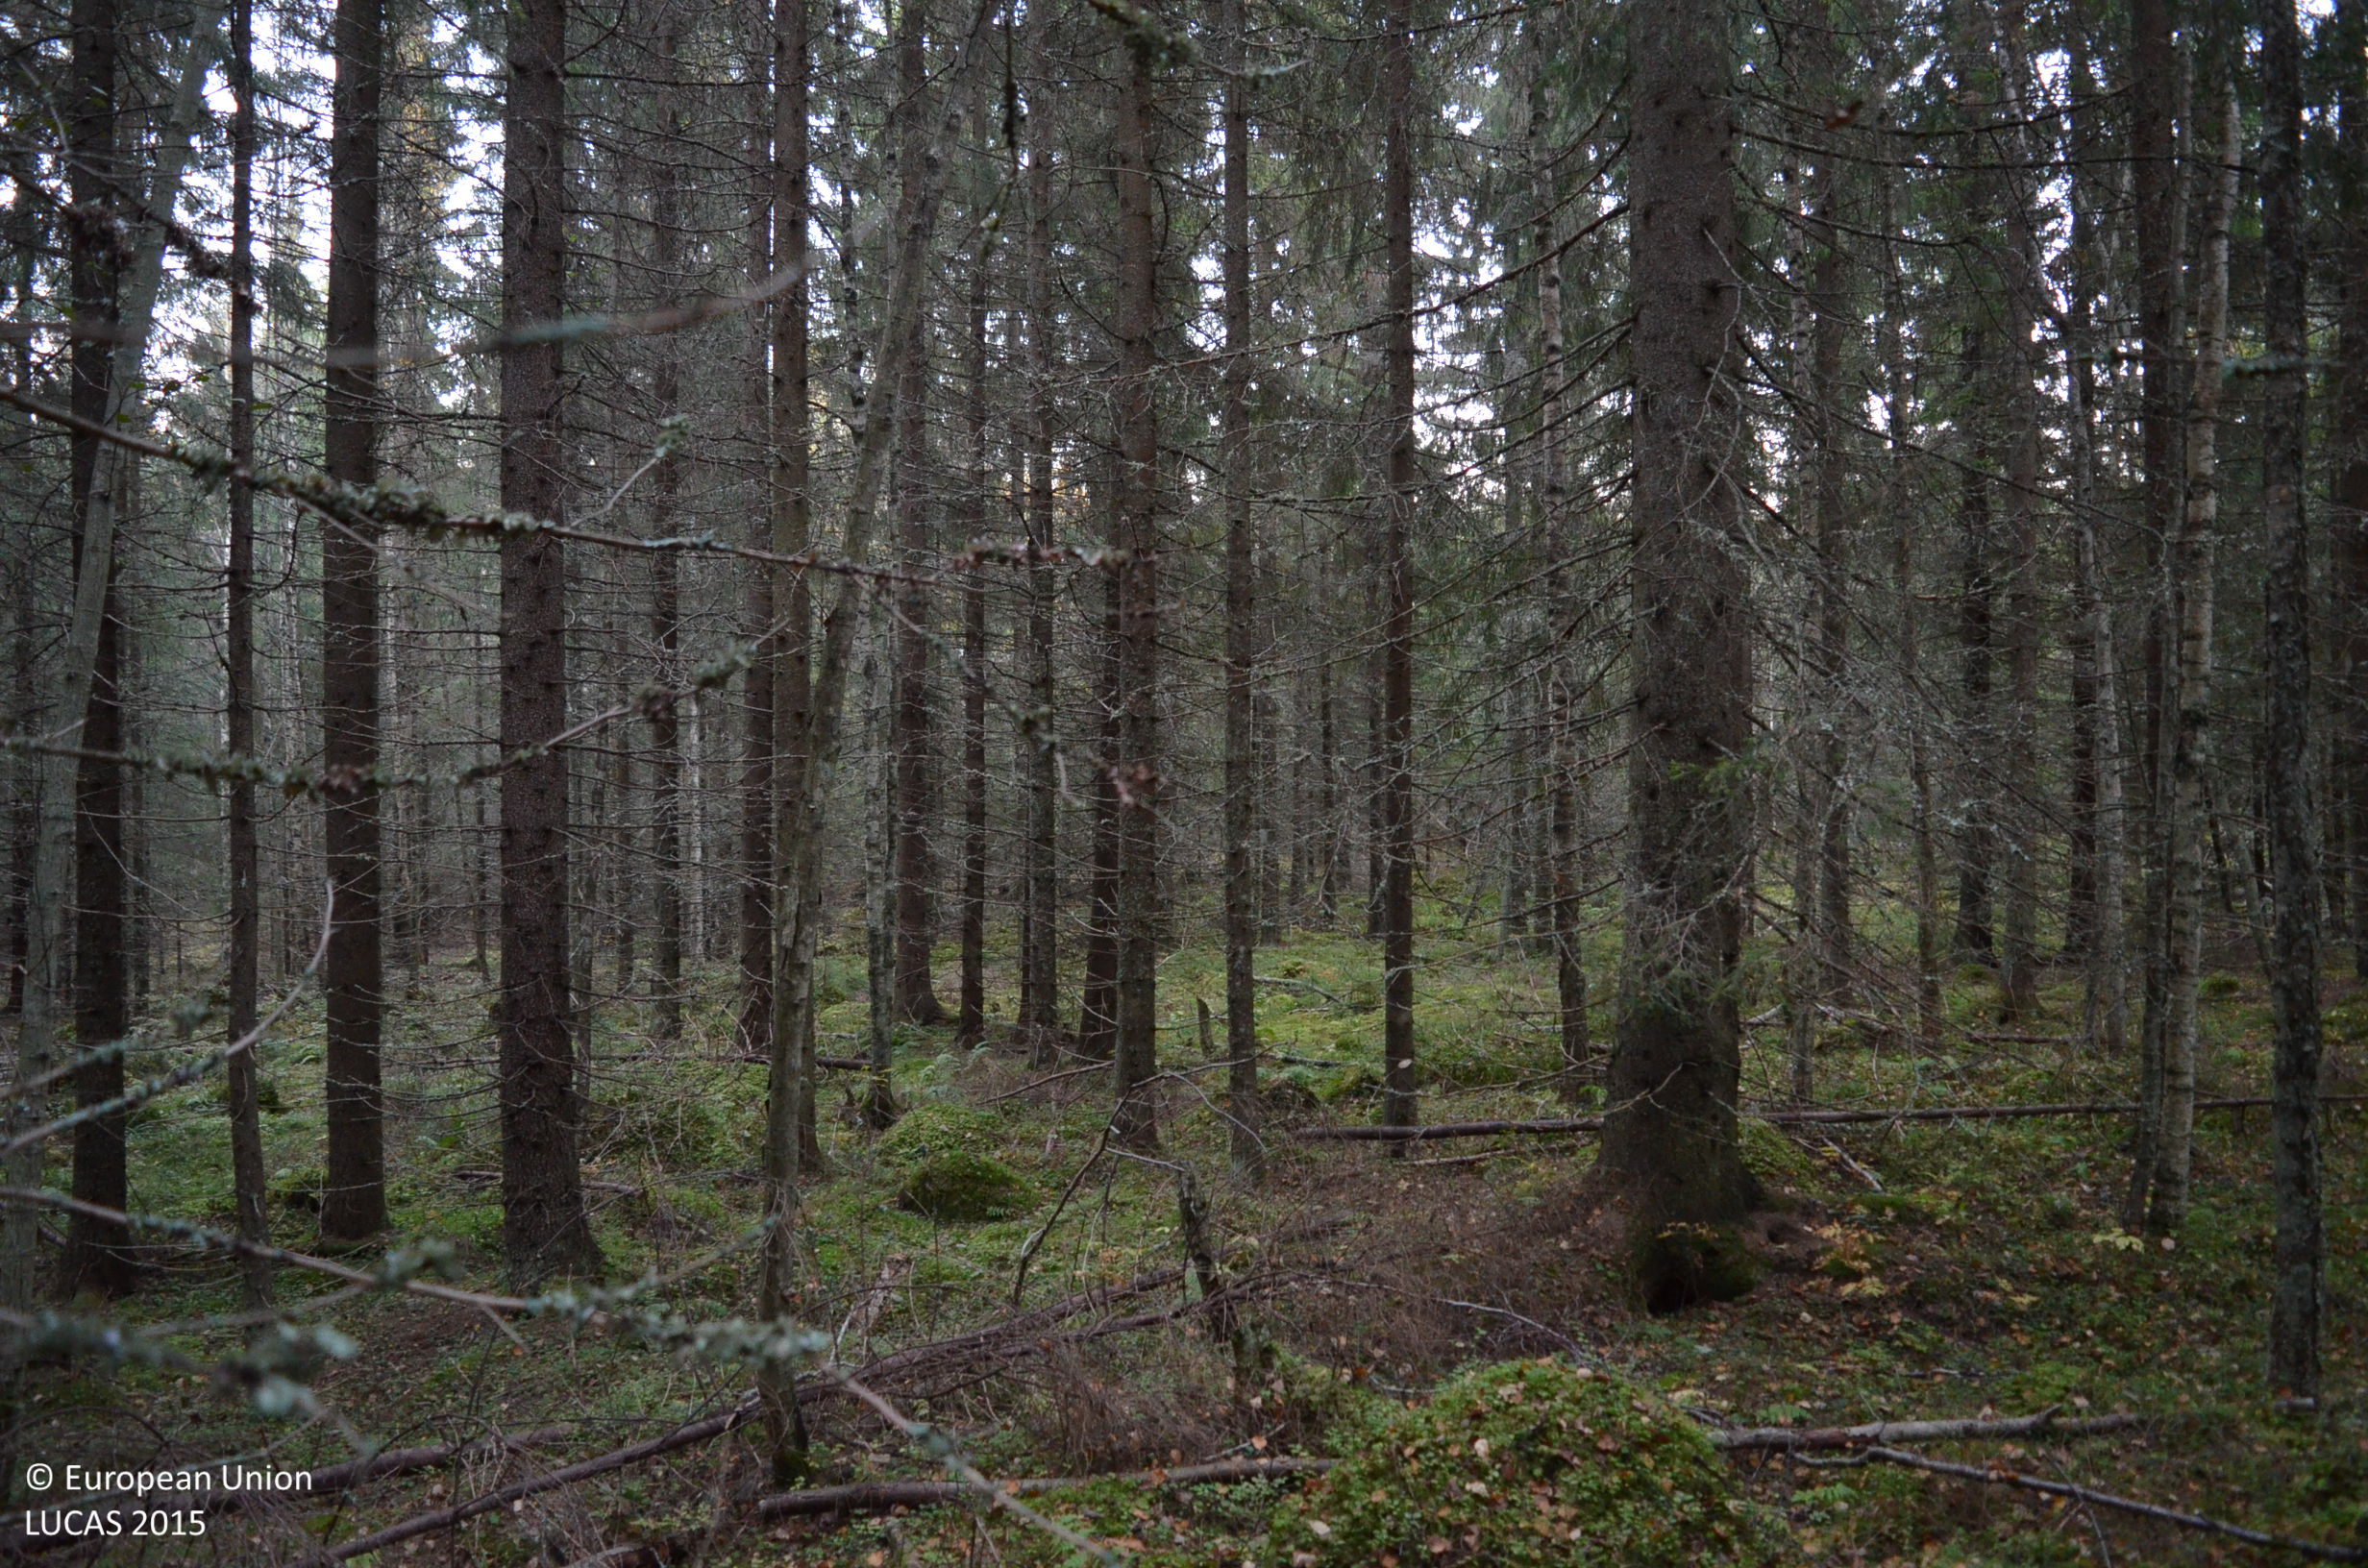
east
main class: Woodland
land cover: Spruce dominated coniferous woodland
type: boreal forest
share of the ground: > 75 %
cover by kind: coniferous forest trees 70 %, broadleaved forest trees 10 %, shrubs 5 %, herbaceous plants 5 %, lichens and mosses 5 %
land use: Forestry
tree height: > 5 m
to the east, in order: Spruce dominated coniferous woodland; Spruce dominated mixed woodland; Ditches and canals; Spruce dominated mixed woodland; Other coniferous woodland; Other mixed woodland; Grass margins; Paved roads, cycling and walking lanes; Ditches and canals; Shrubland with sparse tree cover; Electric lines; Other mixed woodland
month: October
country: FI
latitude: 61.8710
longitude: 23.9065
